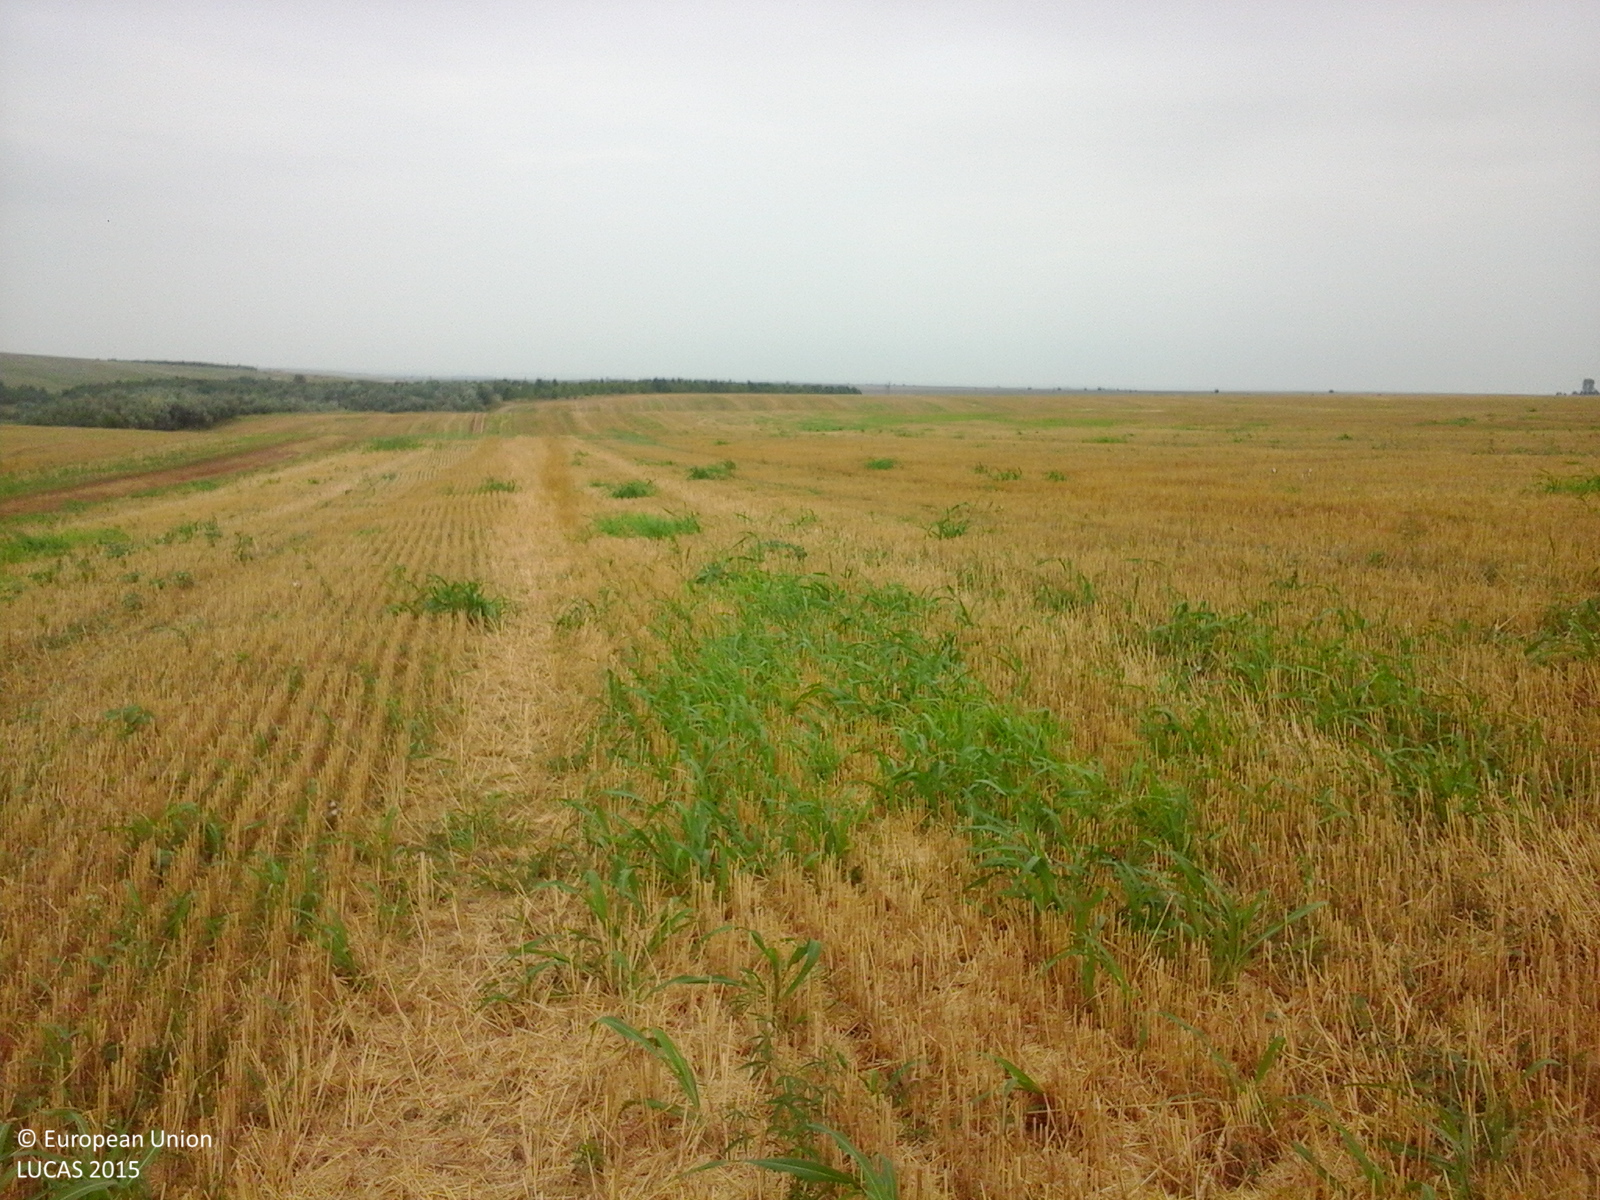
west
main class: Cropland
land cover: Durum wheat
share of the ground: 50 - 75 %
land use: Agriculture (excluding fallow land and kitchen gardens)
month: August
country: RO
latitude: 44.8424
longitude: 28.2221
